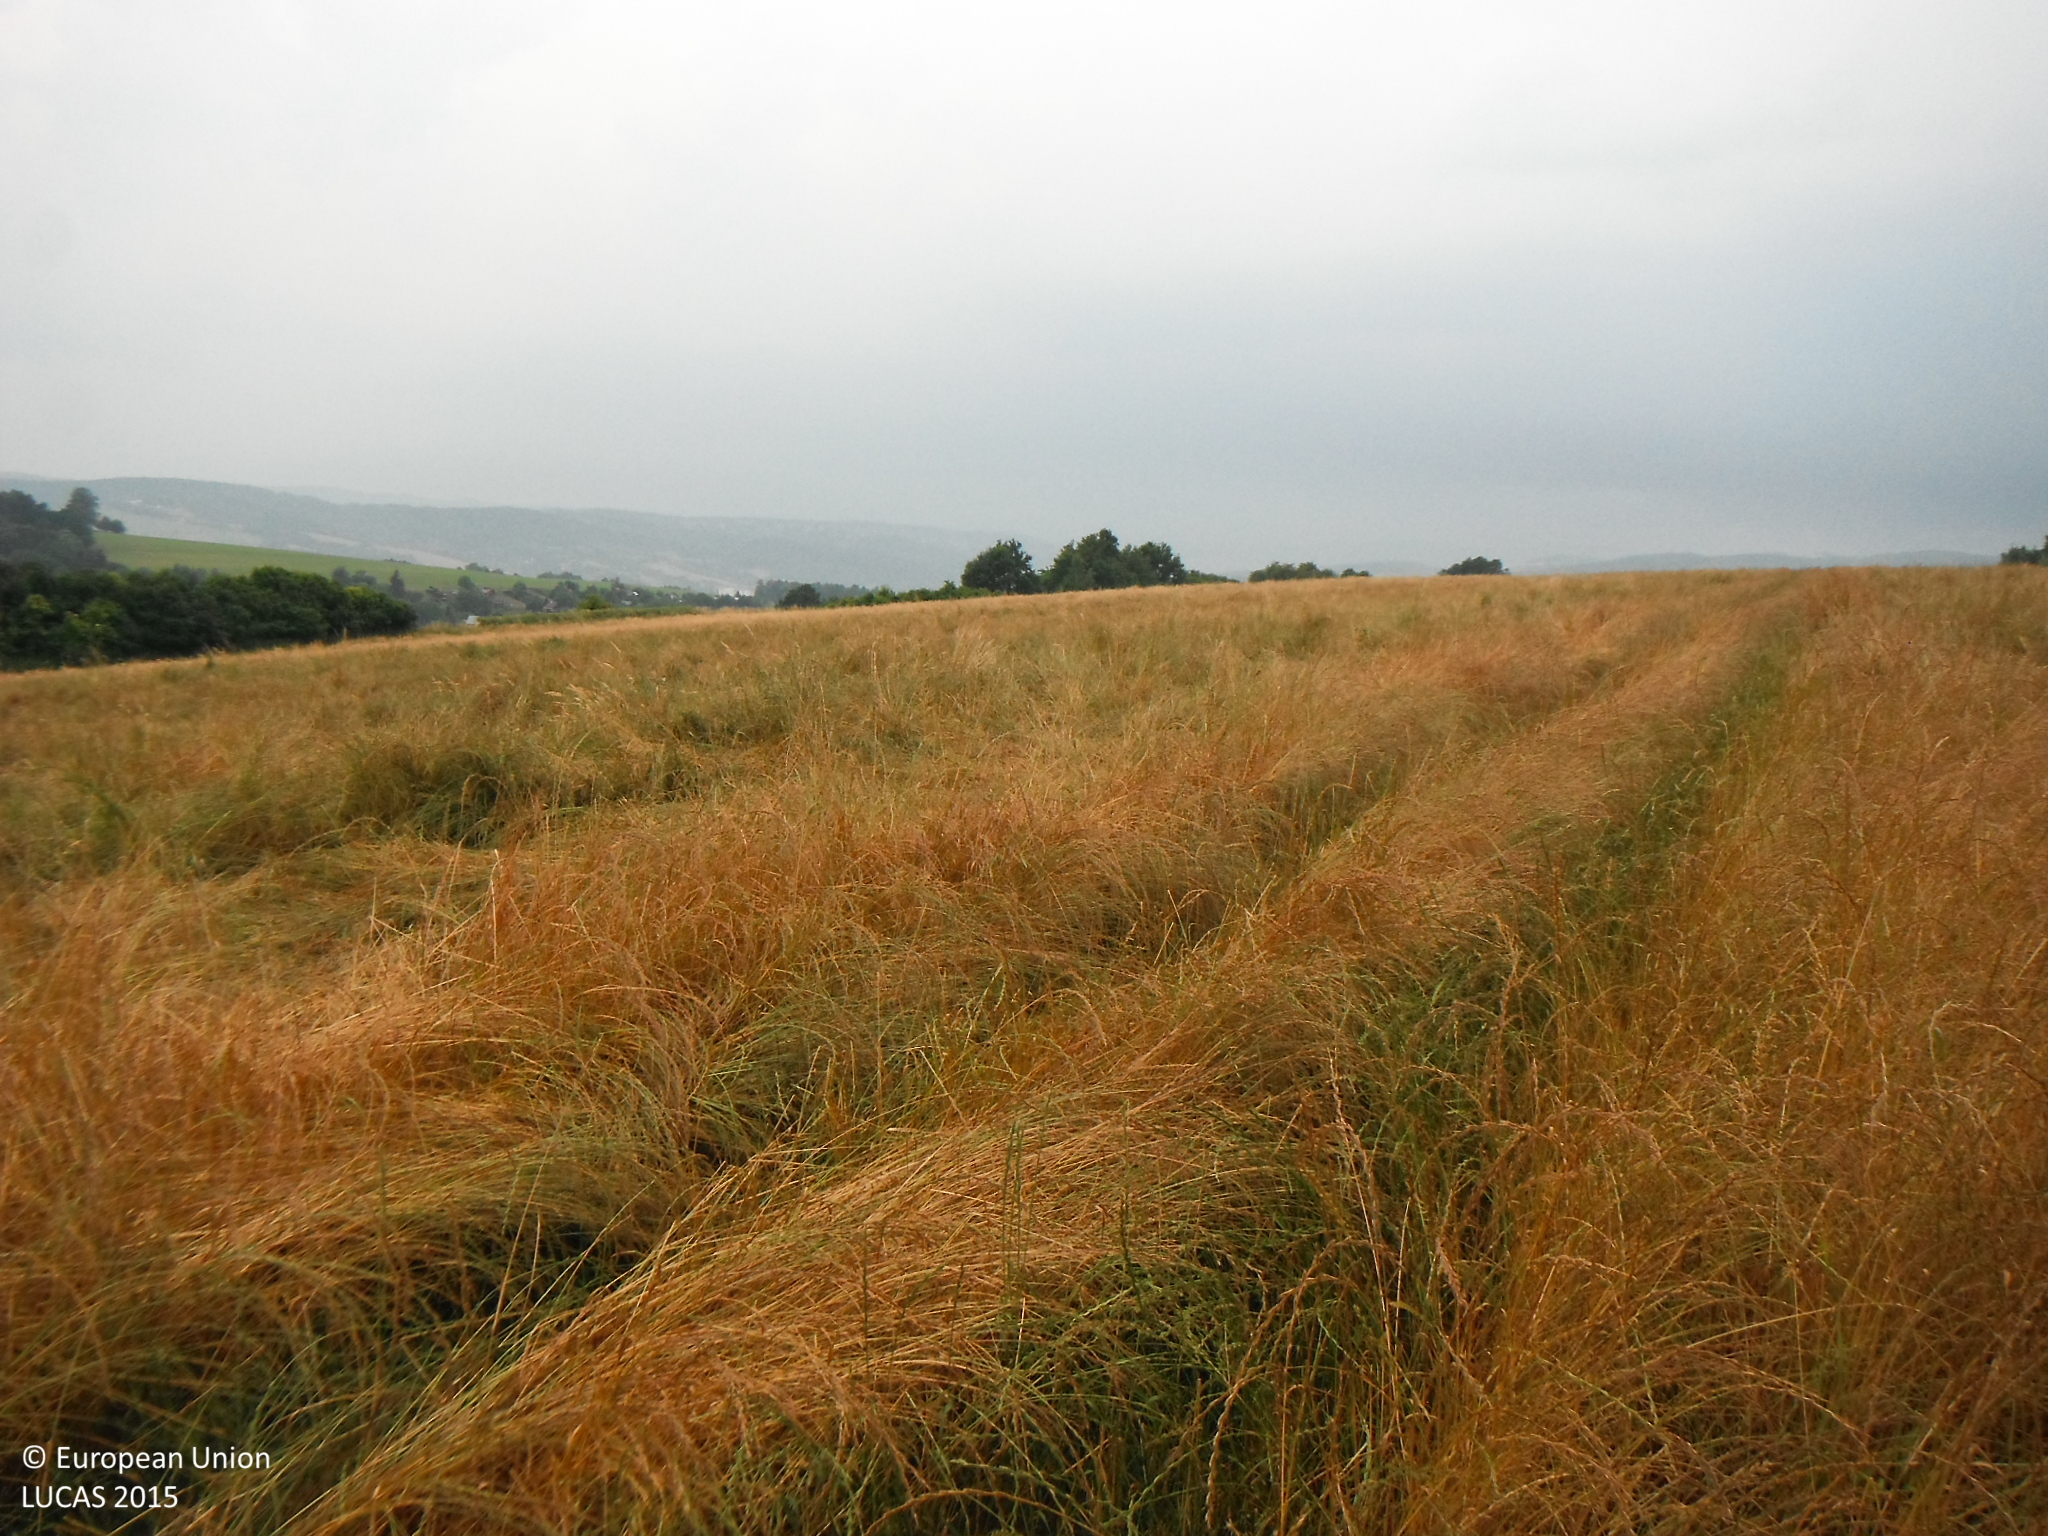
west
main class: Grassland
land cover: Grassland without tree/shrub cover
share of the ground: > 75 %
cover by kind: herbaceous plants 100 %
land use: Agriculture (excluding fallow land and kitchen gardens)
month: July
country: SK
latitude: 49.2928
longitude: 21.3076
